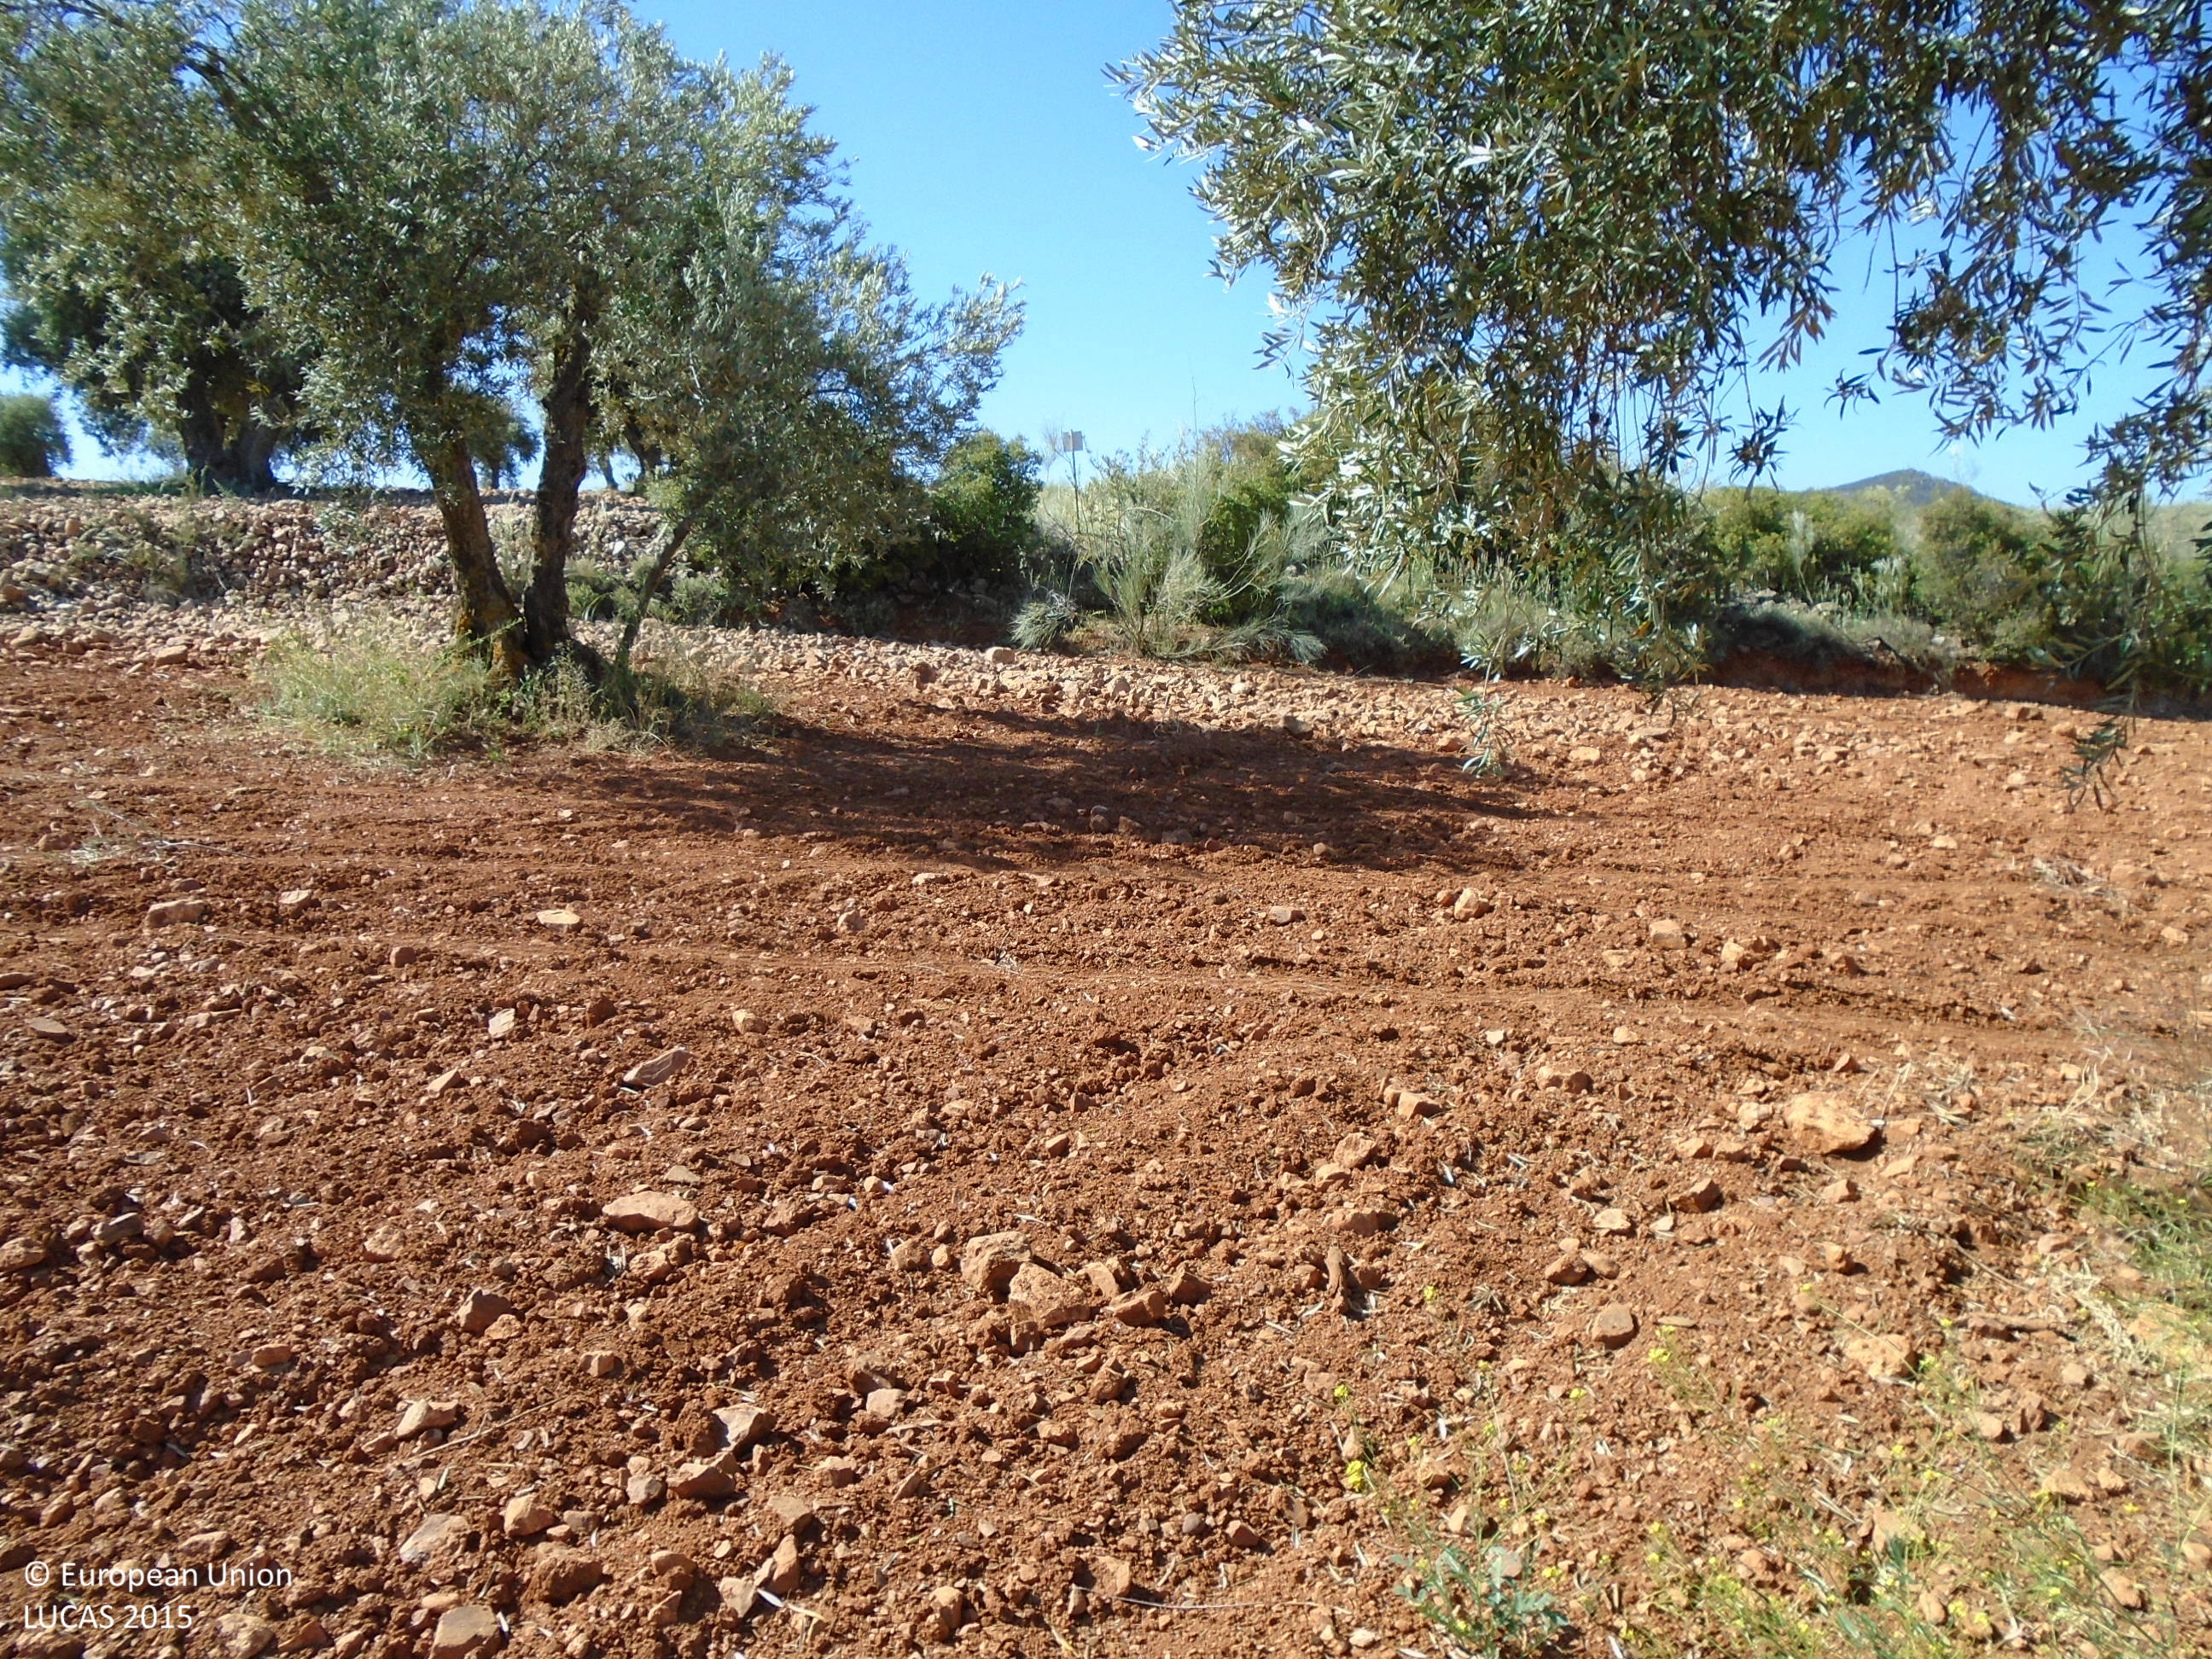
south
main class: Cropland
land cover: Olive groves
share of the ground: 10 - 25 %
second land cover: Other bare soil
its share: > 75 %
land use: Agriculture (excluding fallow land and kitchen gardens)
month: May
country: ES
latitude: 39.7064
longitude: -3.6857
